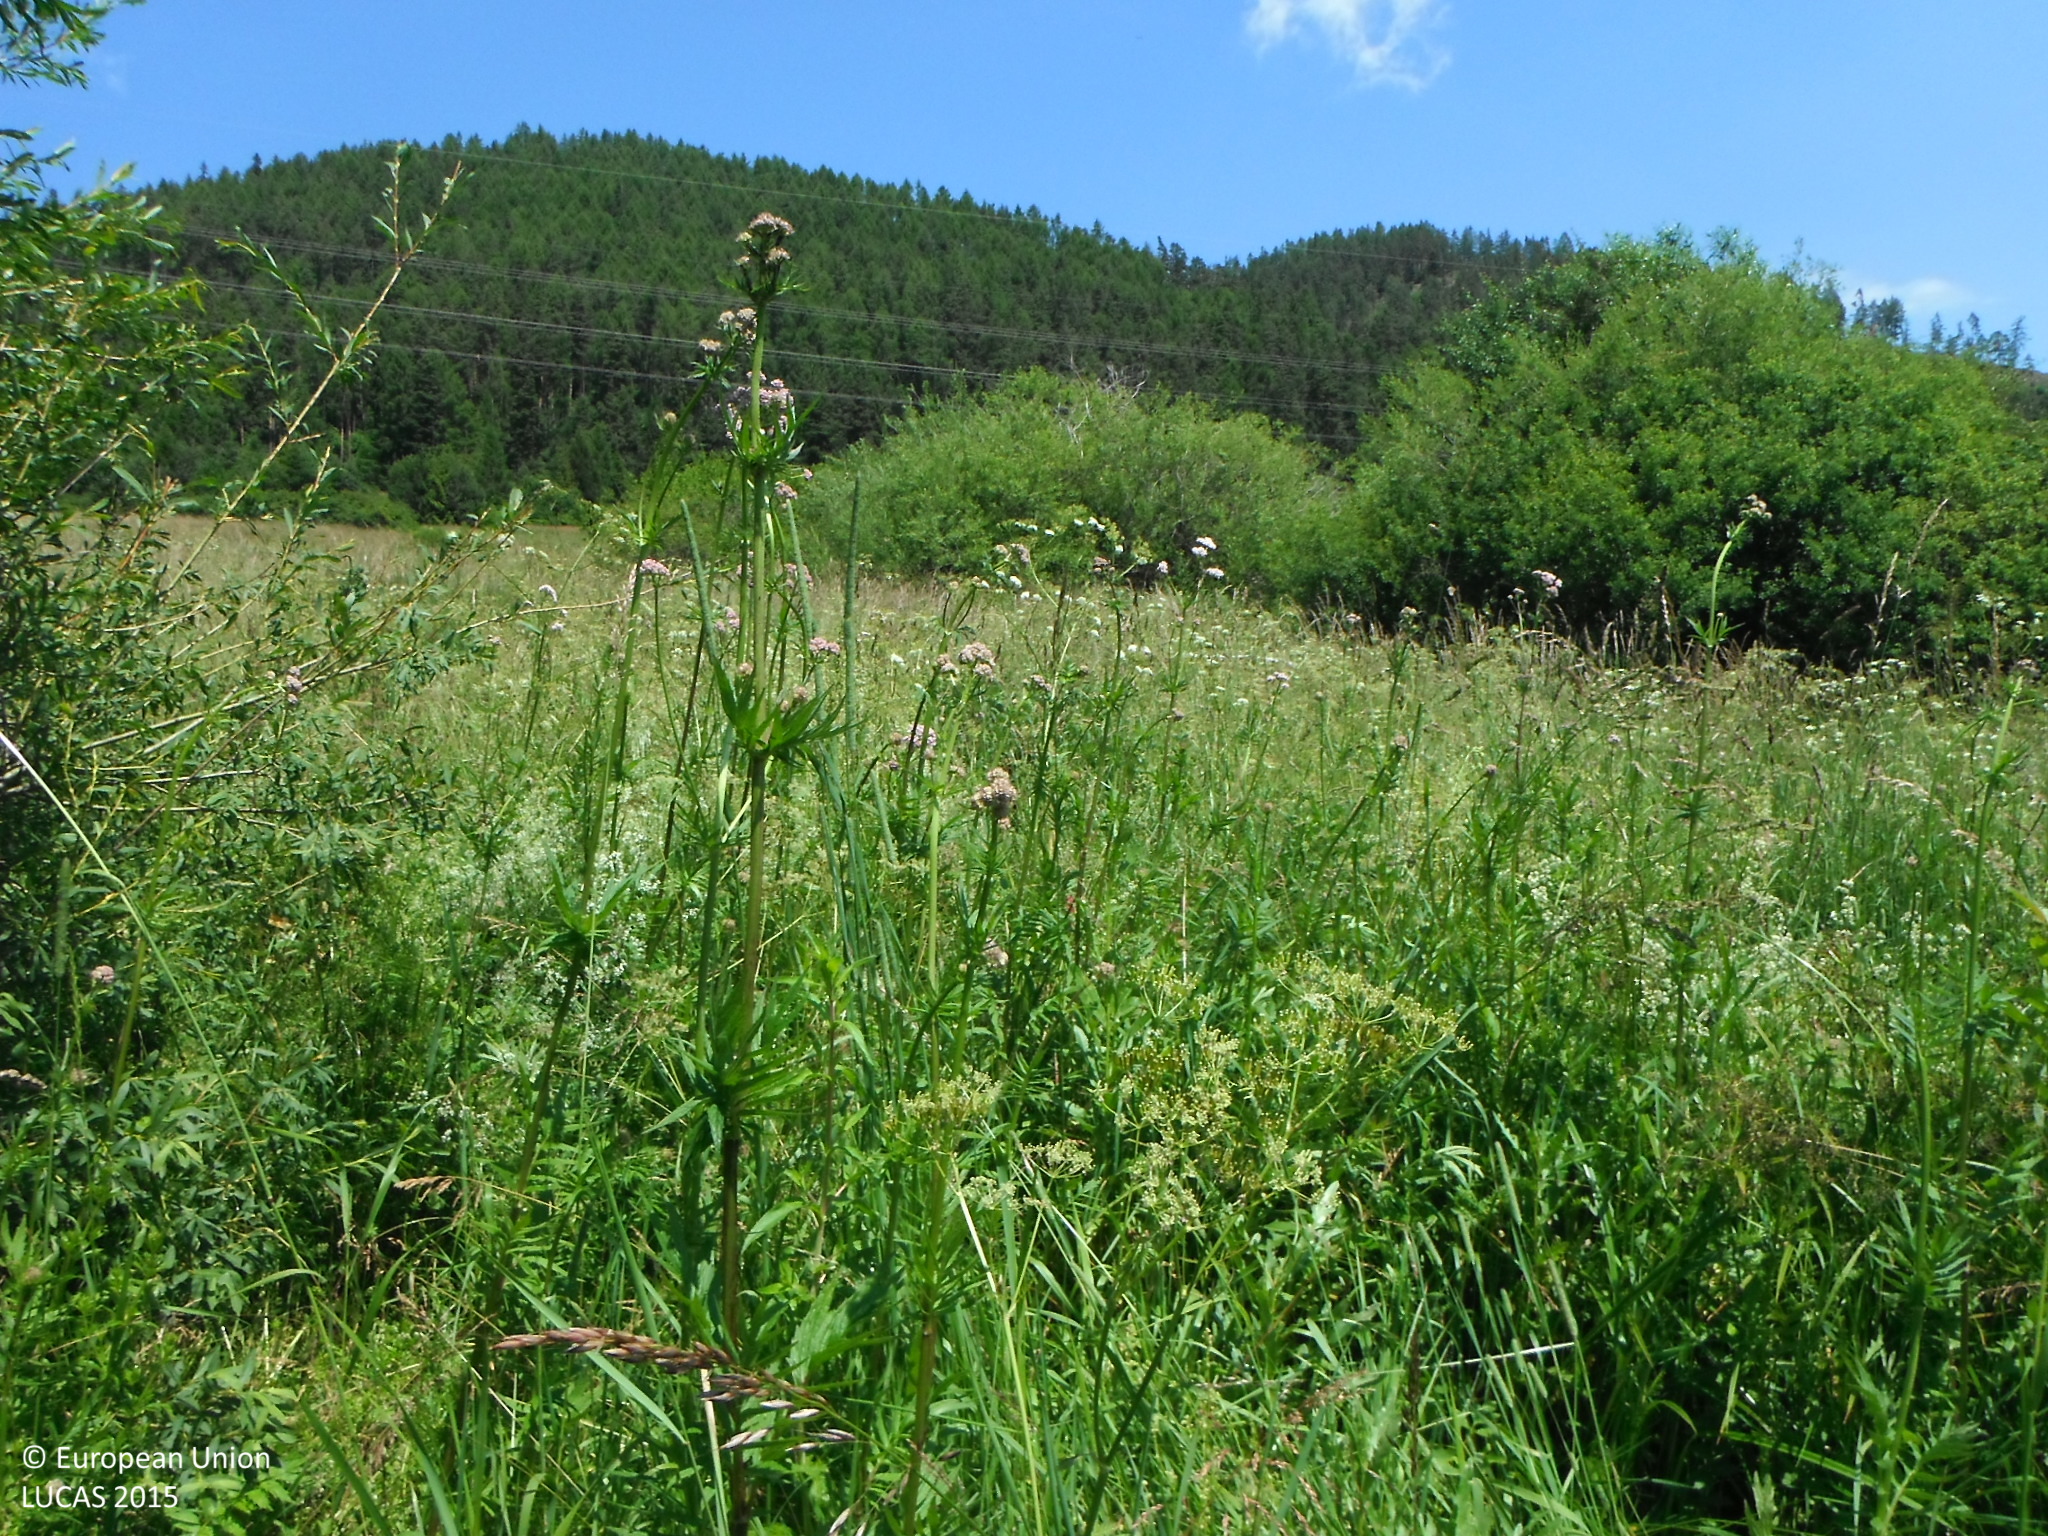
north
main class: Shrubland
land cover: Shrubland without tree cover
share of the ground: > 75 %
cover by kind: shrubs 100 %
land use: Semi-natural and natural areas not in use
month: July
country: SK
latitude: 49.0014
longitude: 20.1889
